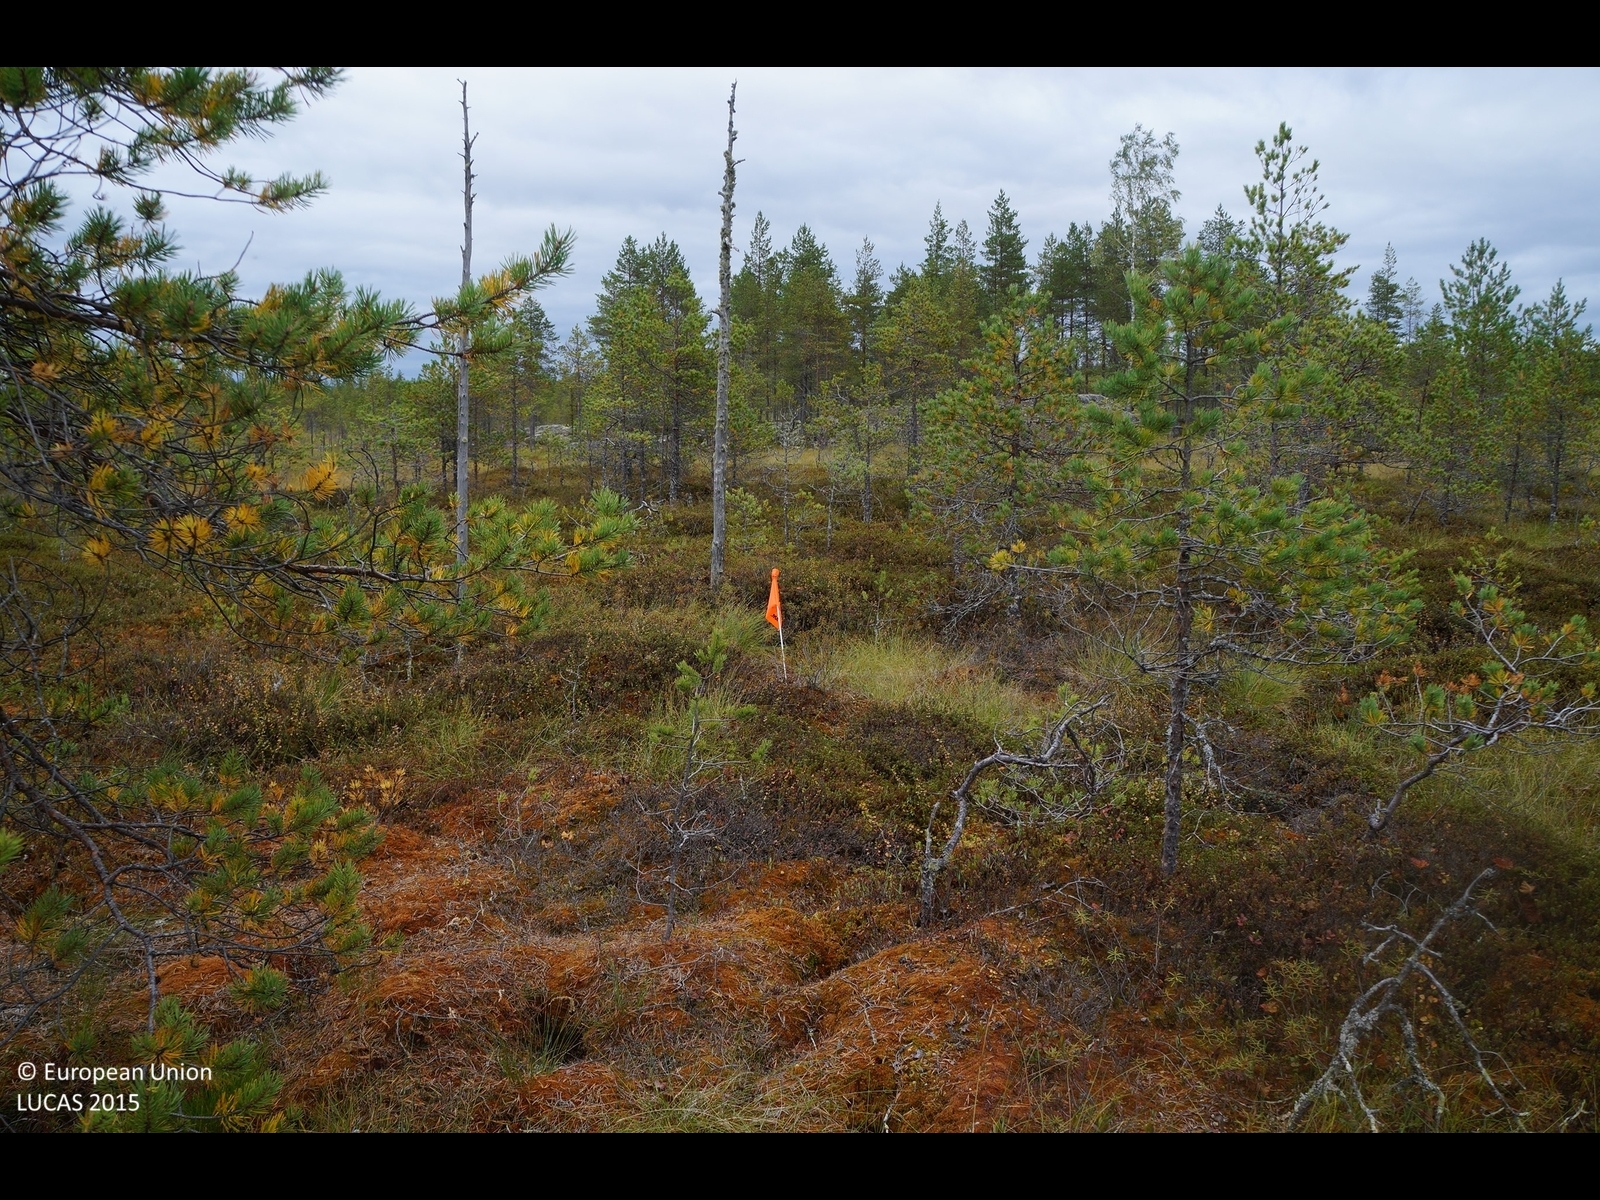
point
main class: Woodland
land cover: Pine dominated coniferous woodland
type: boreal forest
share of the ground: 25 - 50 %
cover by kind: shrubs 30 %, lichens and mosses 30 %, coniferous forest trees 25 %, herbaceous plants 15 %
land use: Semi-natural and natural areas not in use
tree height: < 5 m
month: September
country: FI
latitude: 64.0200
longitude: 24.1237
